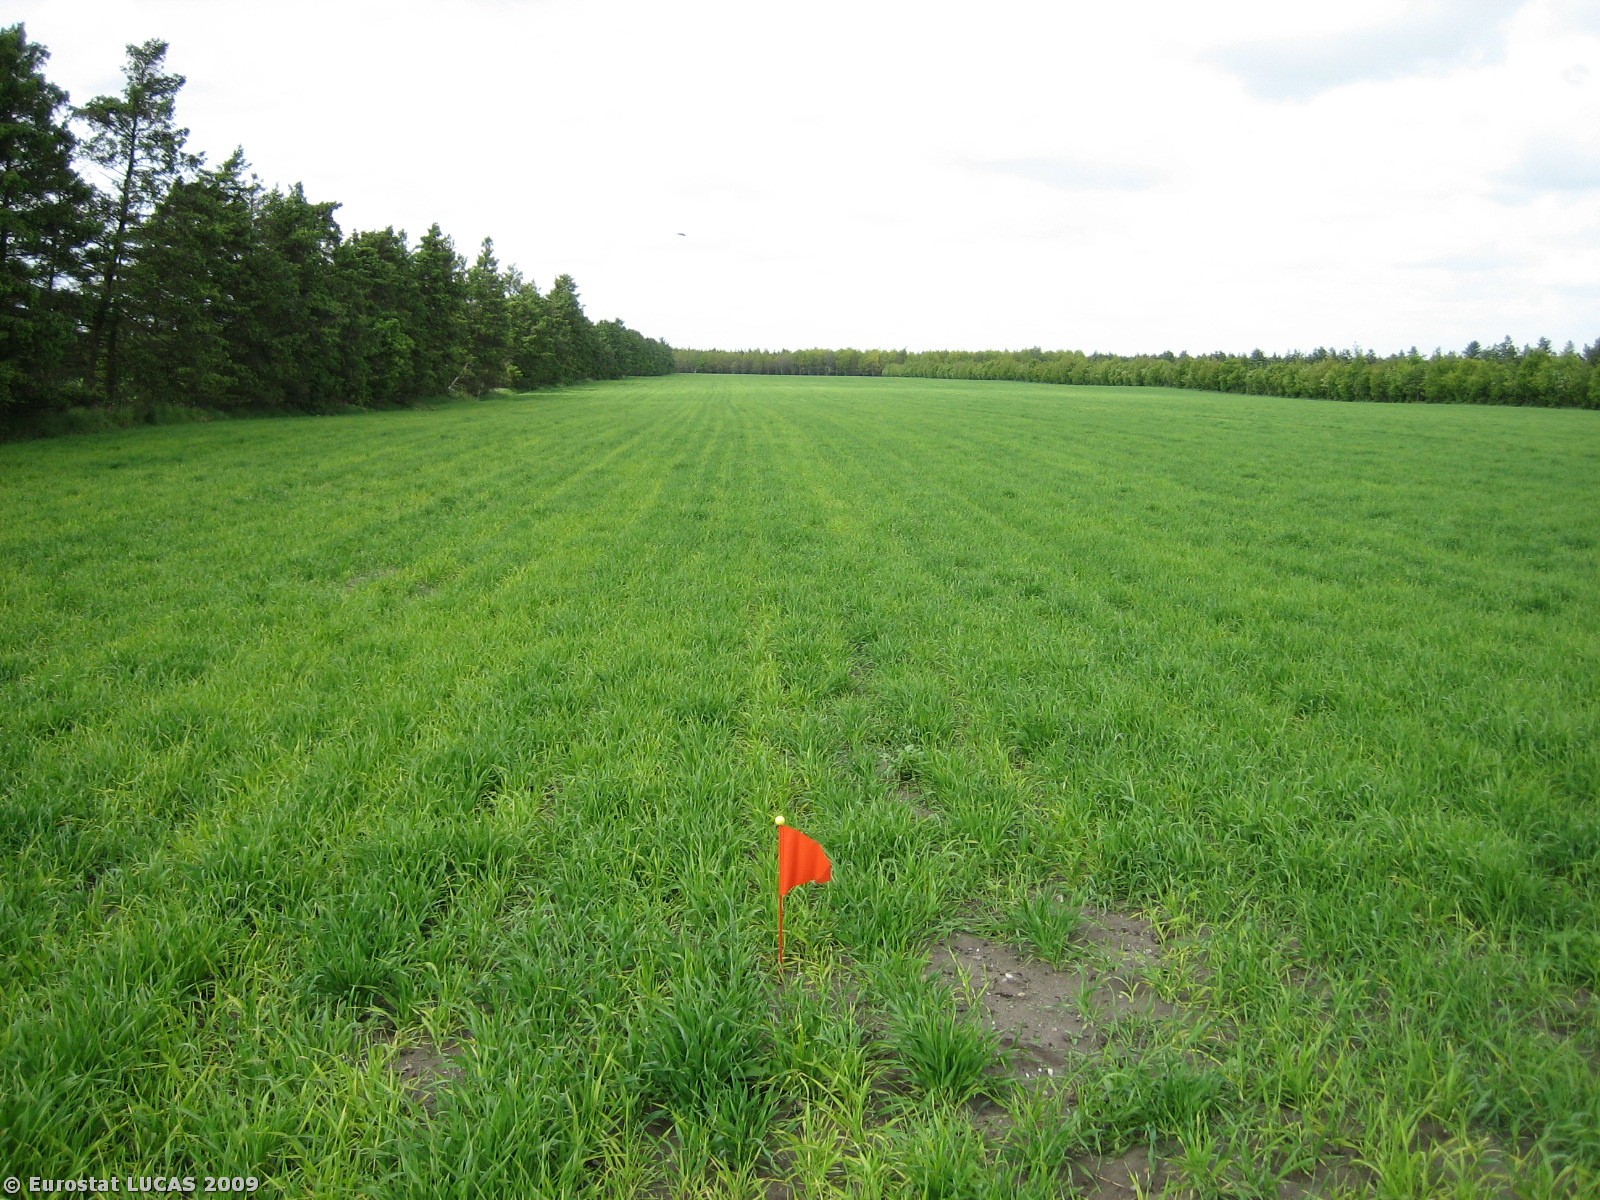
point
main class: Cropland
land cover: Barley
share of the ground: > 75 %
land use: Agriculture (excluding fallow land and kitchen gardens)
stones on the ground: 10 - 25 %
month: May
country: DK
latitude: 56.2192
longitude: 8.9208
